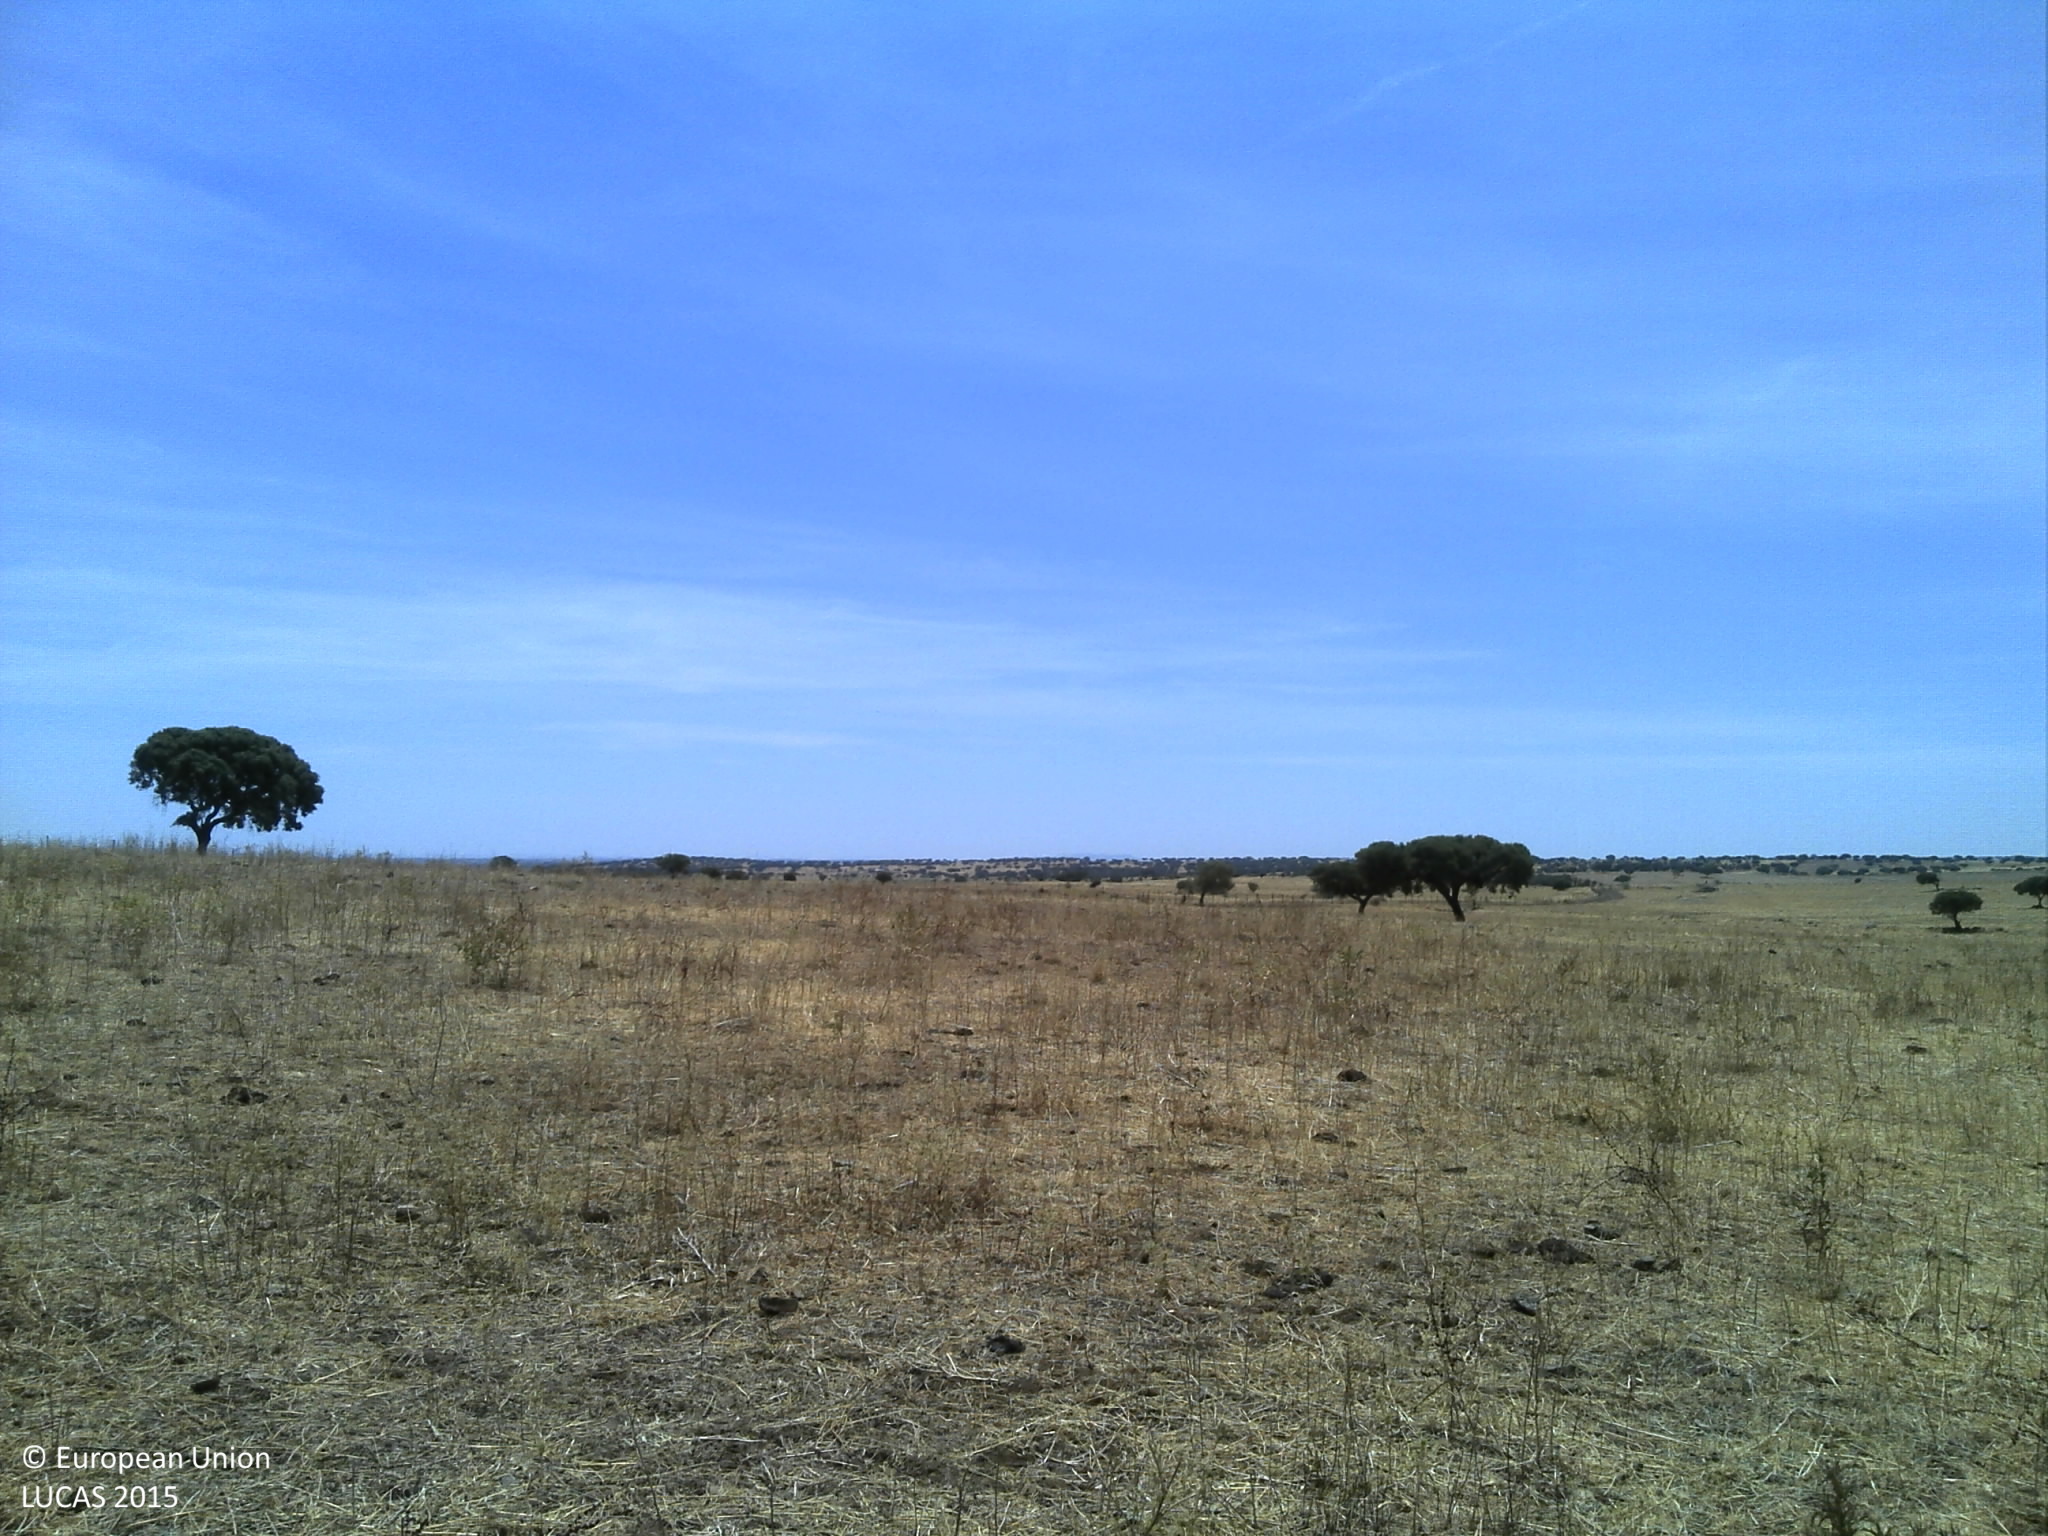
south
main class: Grassland
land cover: Spontaneously vegetated surfaces
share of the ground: 10 - 25 %
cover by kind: unconsolidated bare surface 90 %, herbaceous plants 10 %
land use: Agriculture (excluding fallow land and kitchen gardens)
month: July
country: PT
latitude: 38.3743
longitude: -7.4583
